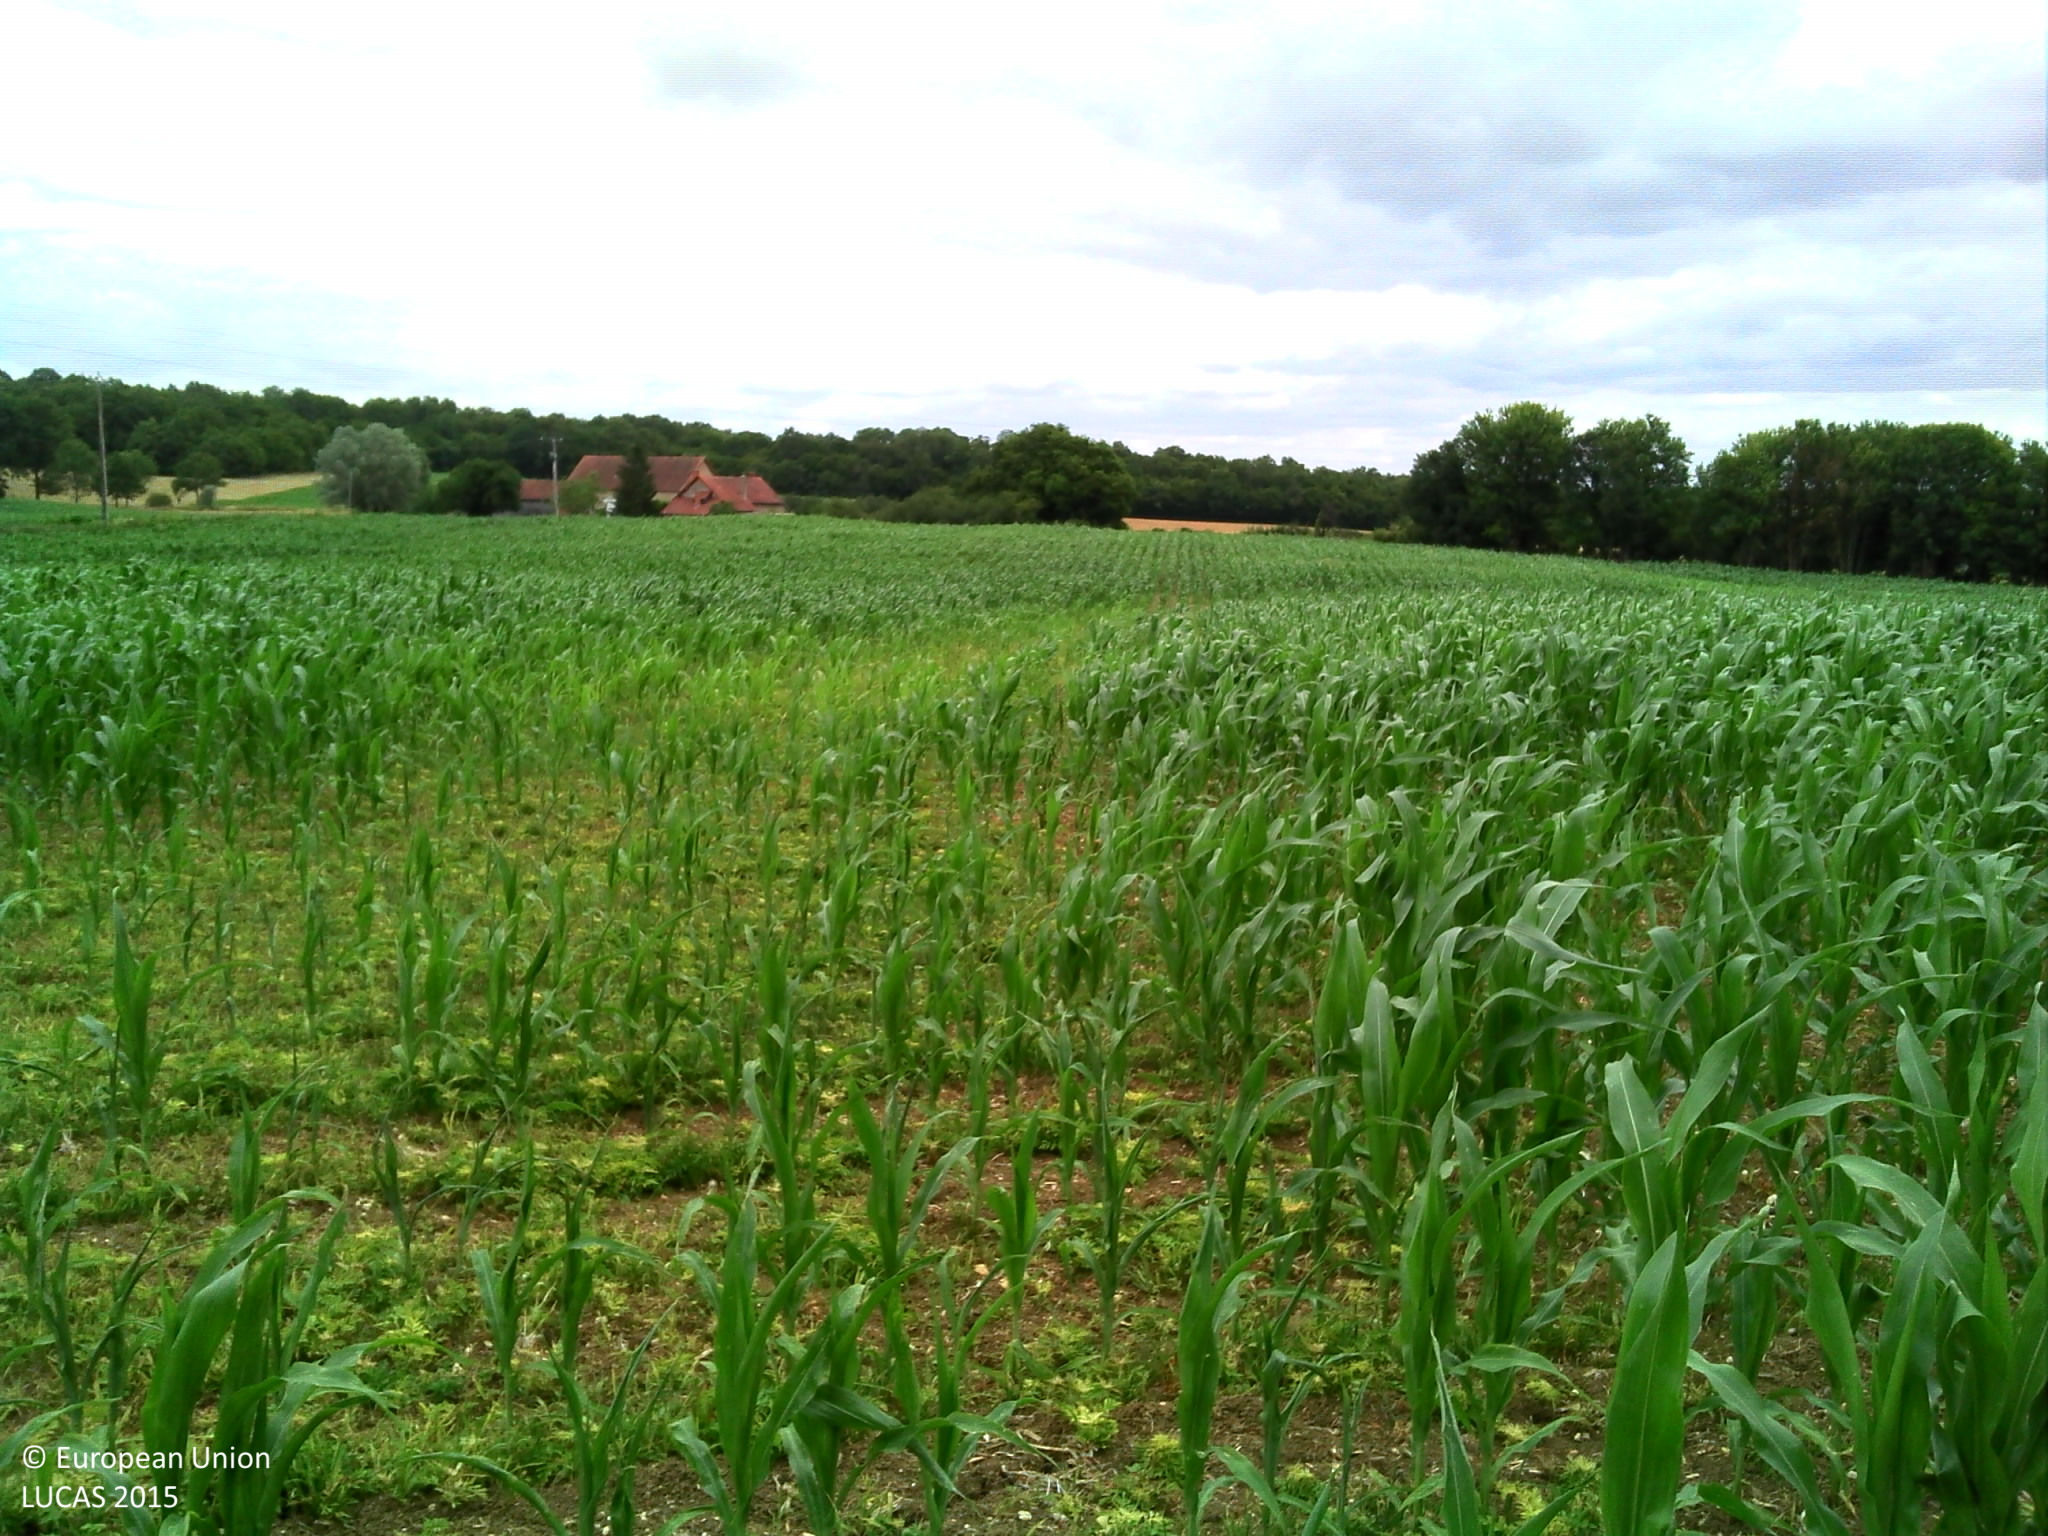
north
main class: Cropland
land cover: Maize
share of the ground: > 75 %
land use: Agriculture (excluding fallow land and kitchen gardens)
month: July
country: FR
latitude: 46.8227
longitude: 3.2202
